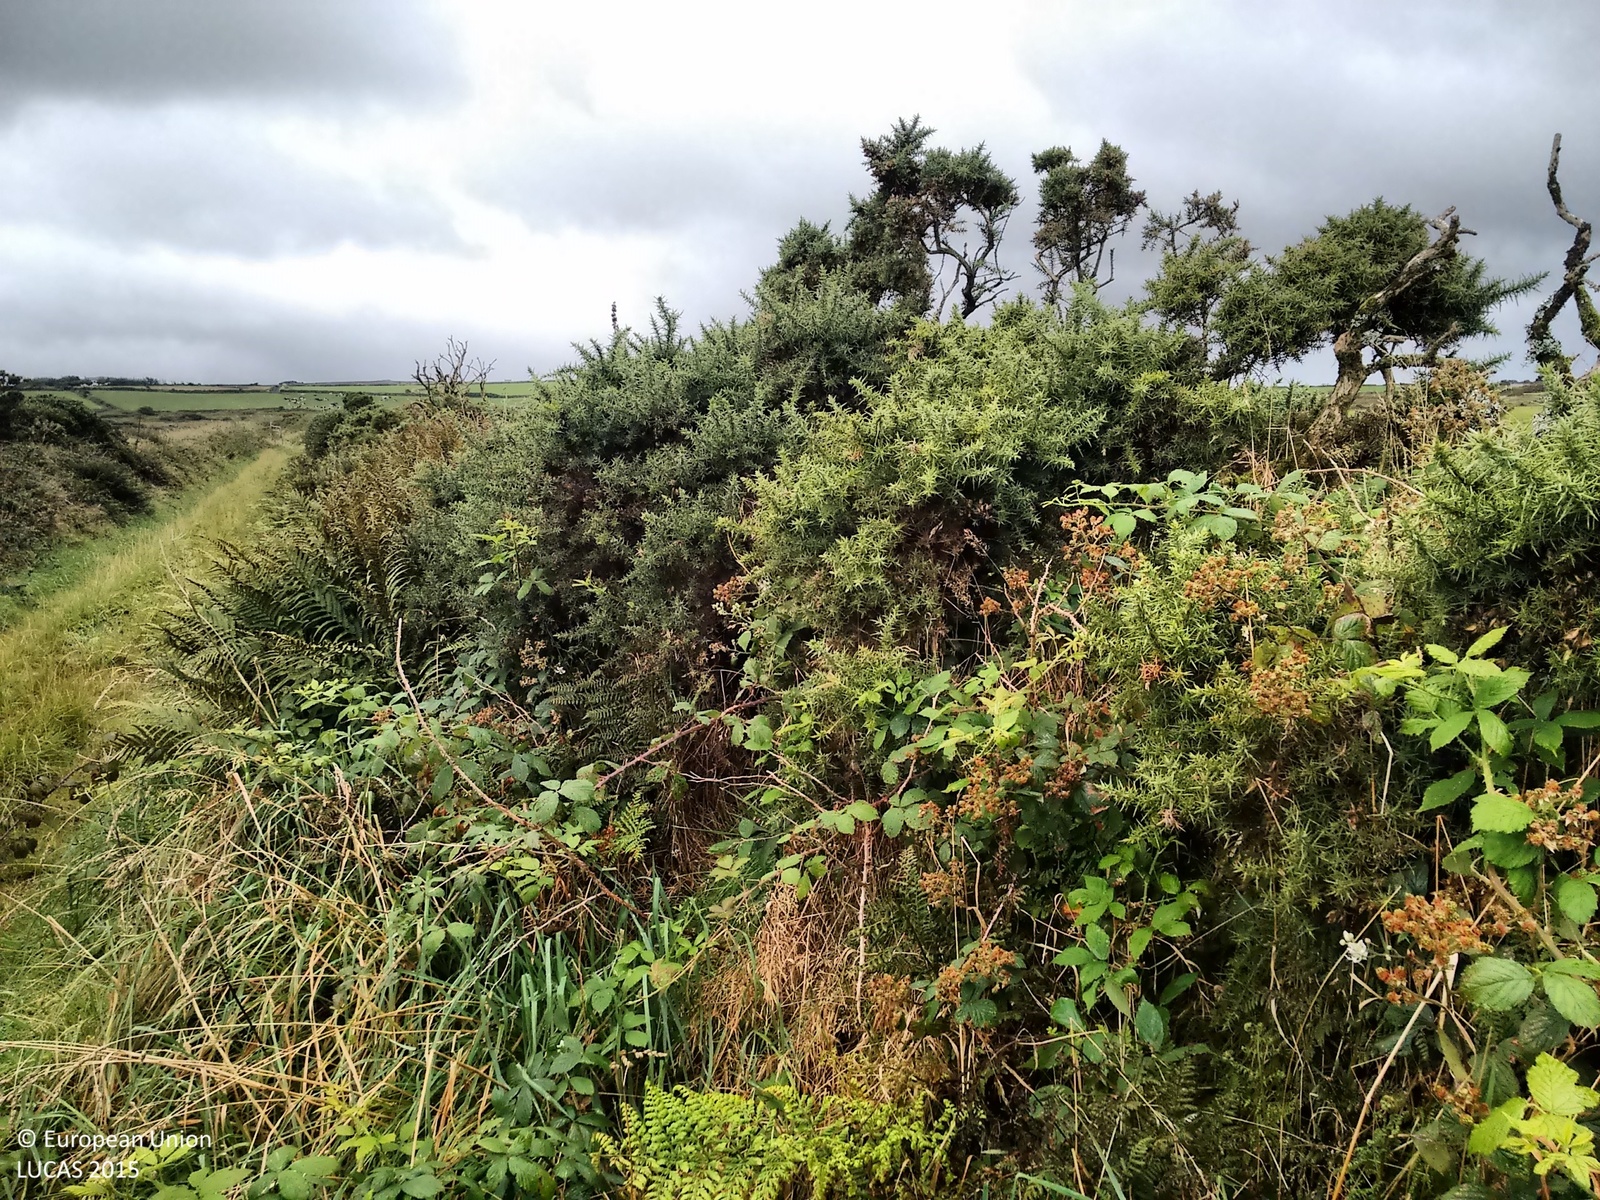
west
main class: Grassland
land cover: Grassland without tree/shrub cover
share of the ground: > 75 %
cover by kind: herbaceous plants 100 %
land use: Agriculture (excluding fallow land and kitchen gardens)
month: September
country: GB
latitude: 50.1957
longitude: -5.2360
